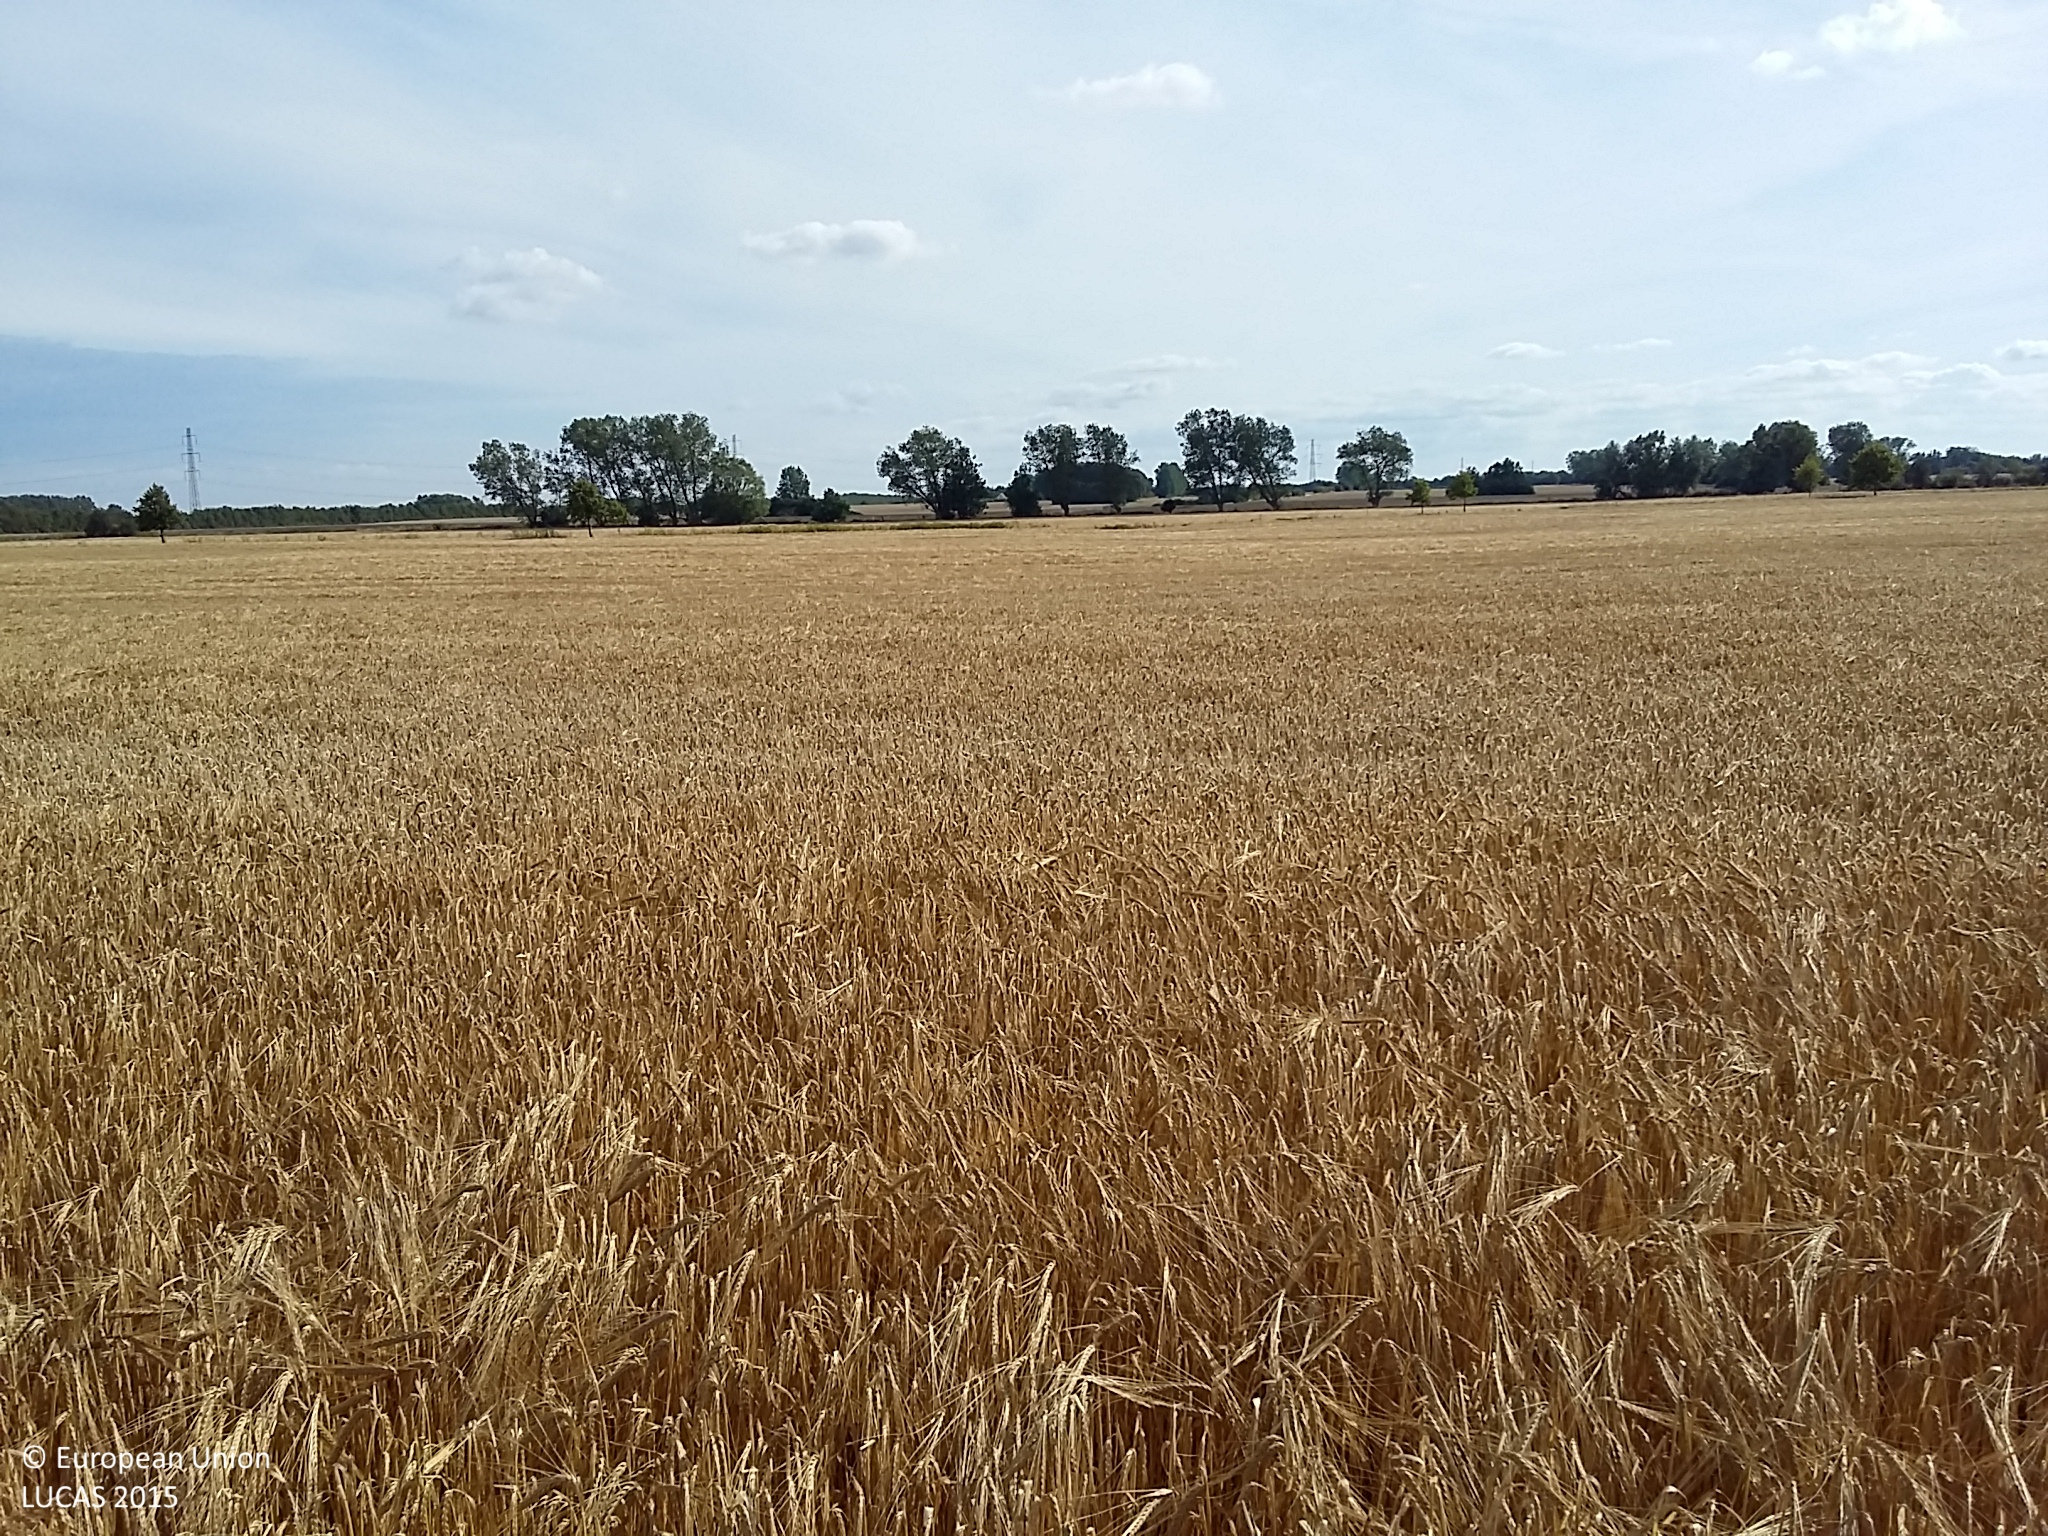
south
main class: Cropland
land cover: Barley
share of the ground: > 75 %
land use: Agriculture (excluding fallow land and kitchen gardens)
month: August
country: DK
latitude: 55.5406
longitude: 12.1376
